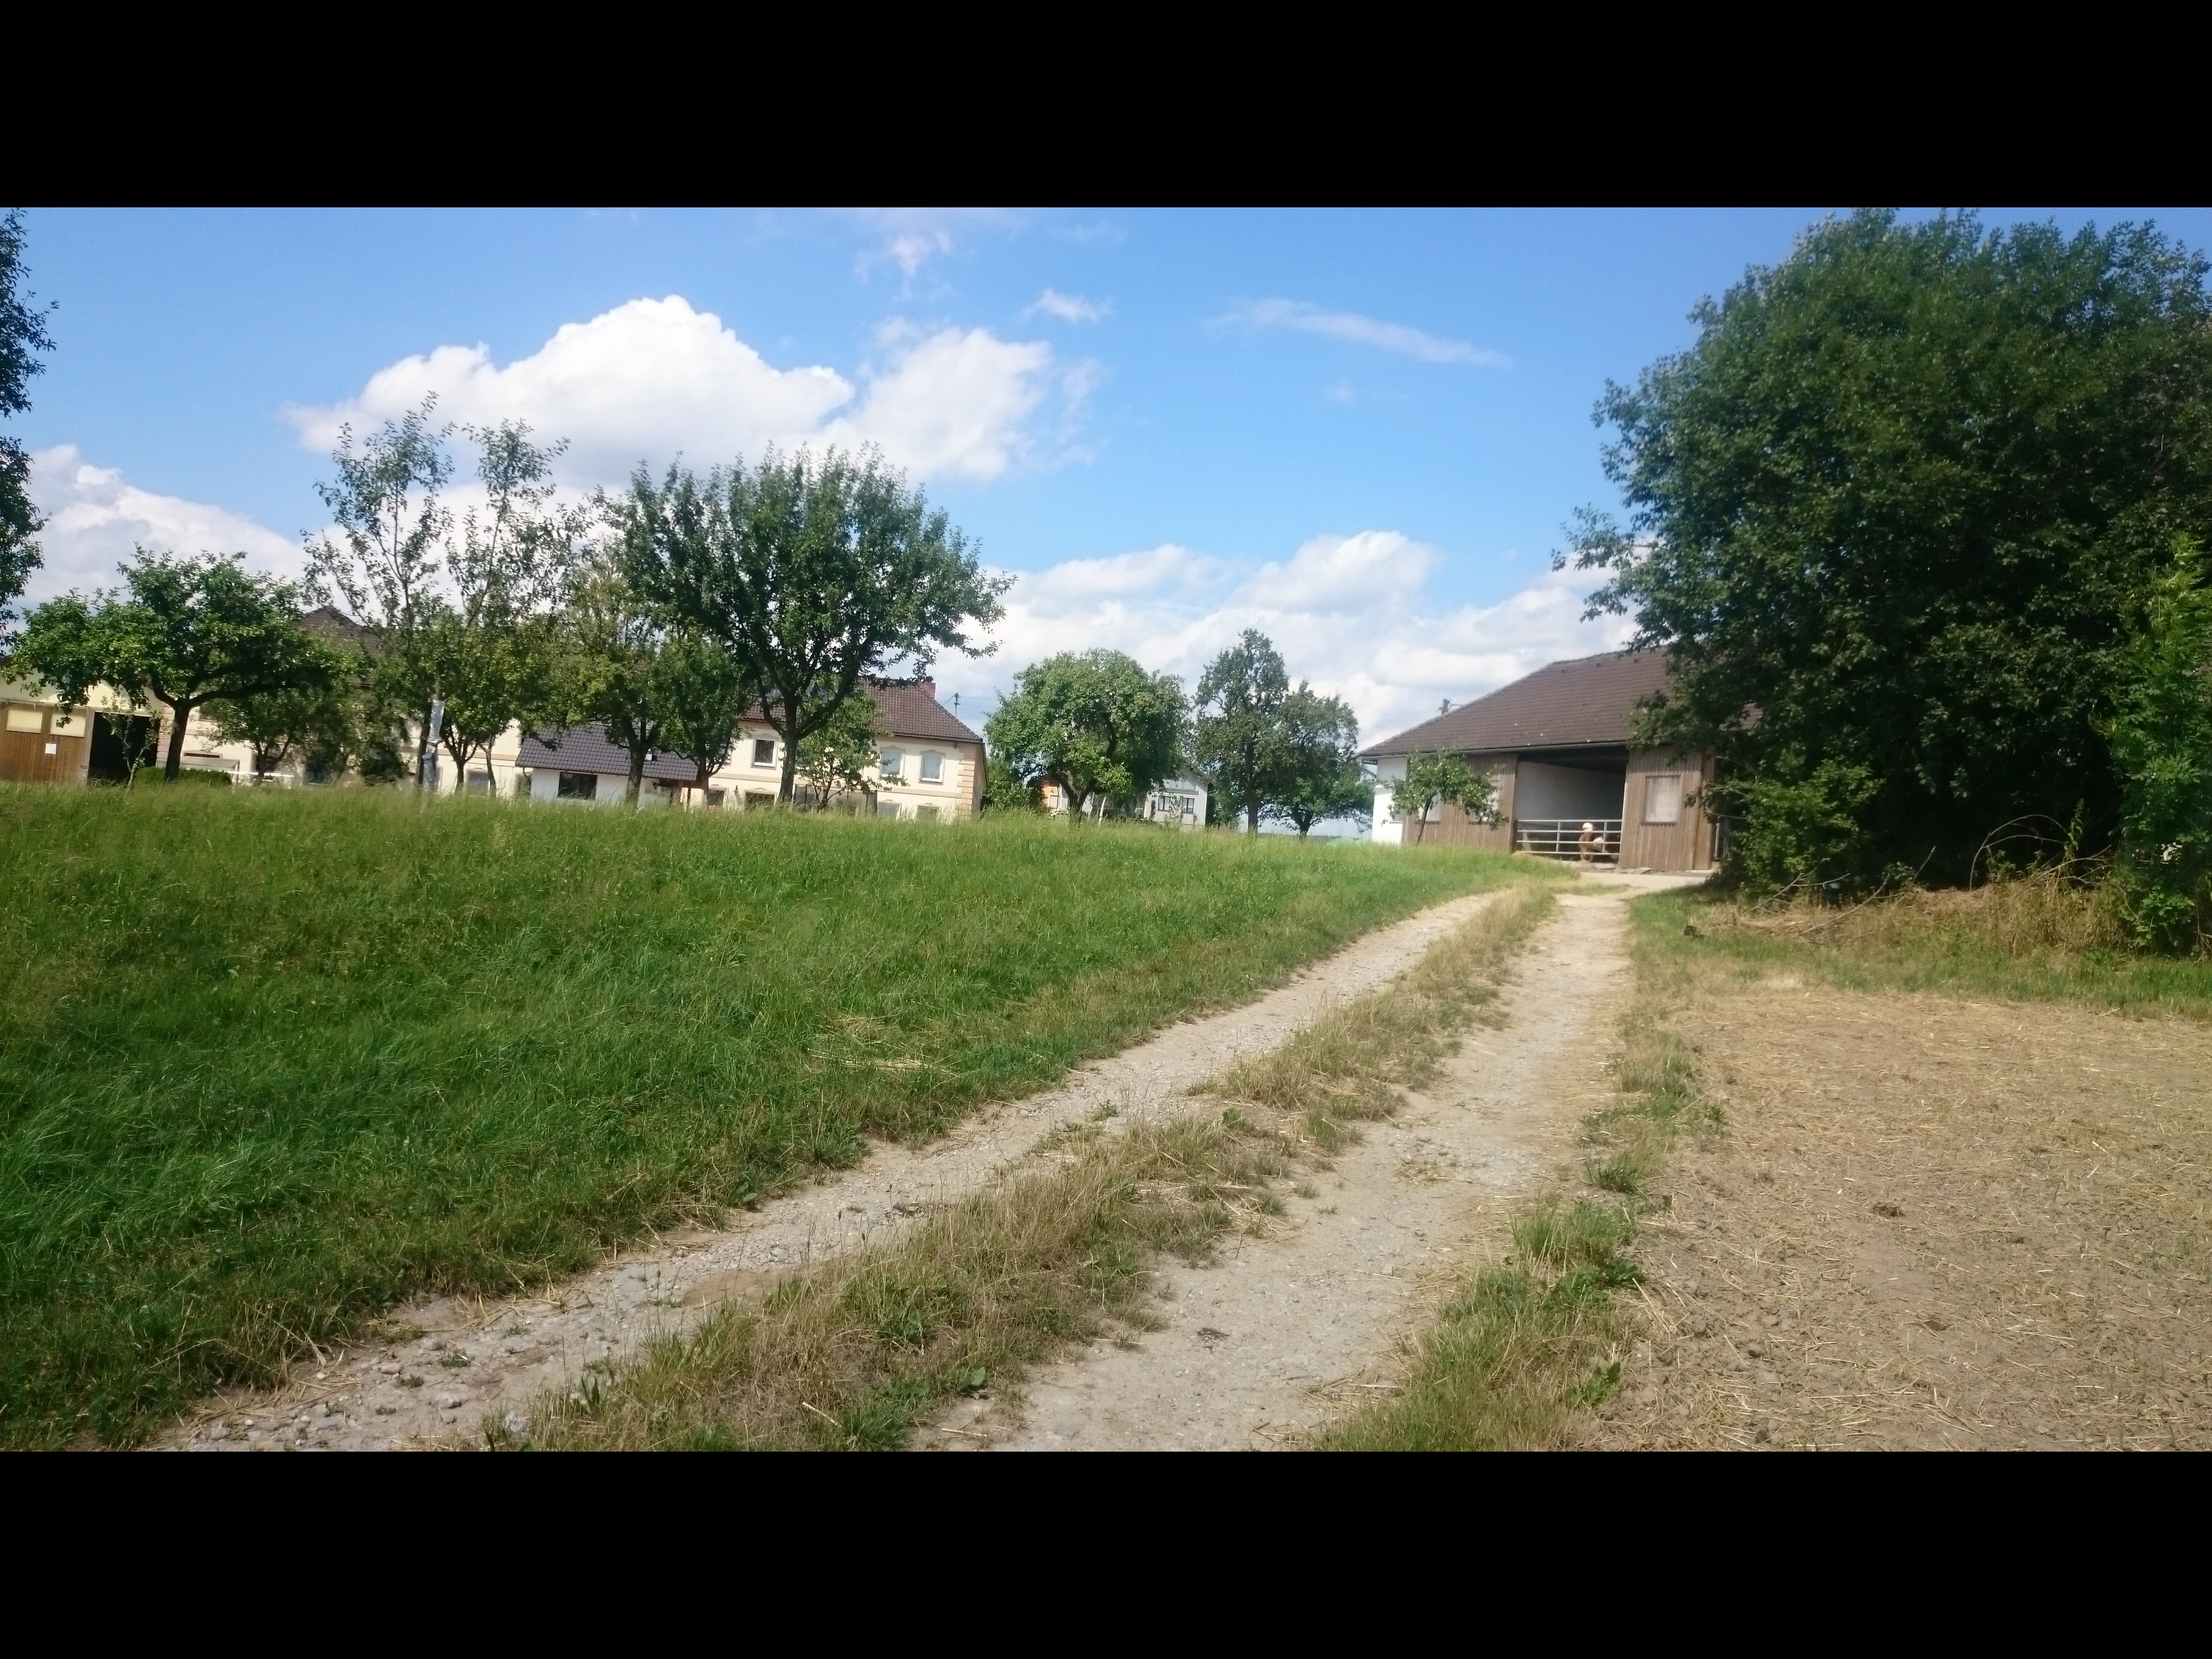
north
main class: Cropland
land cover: Barley
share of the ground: < 10 %
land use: Agriculture (excluding fallow land and kitchen gardens)
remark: Harvested field
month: July
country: AT
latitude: 48.2269
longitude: 14.8066
